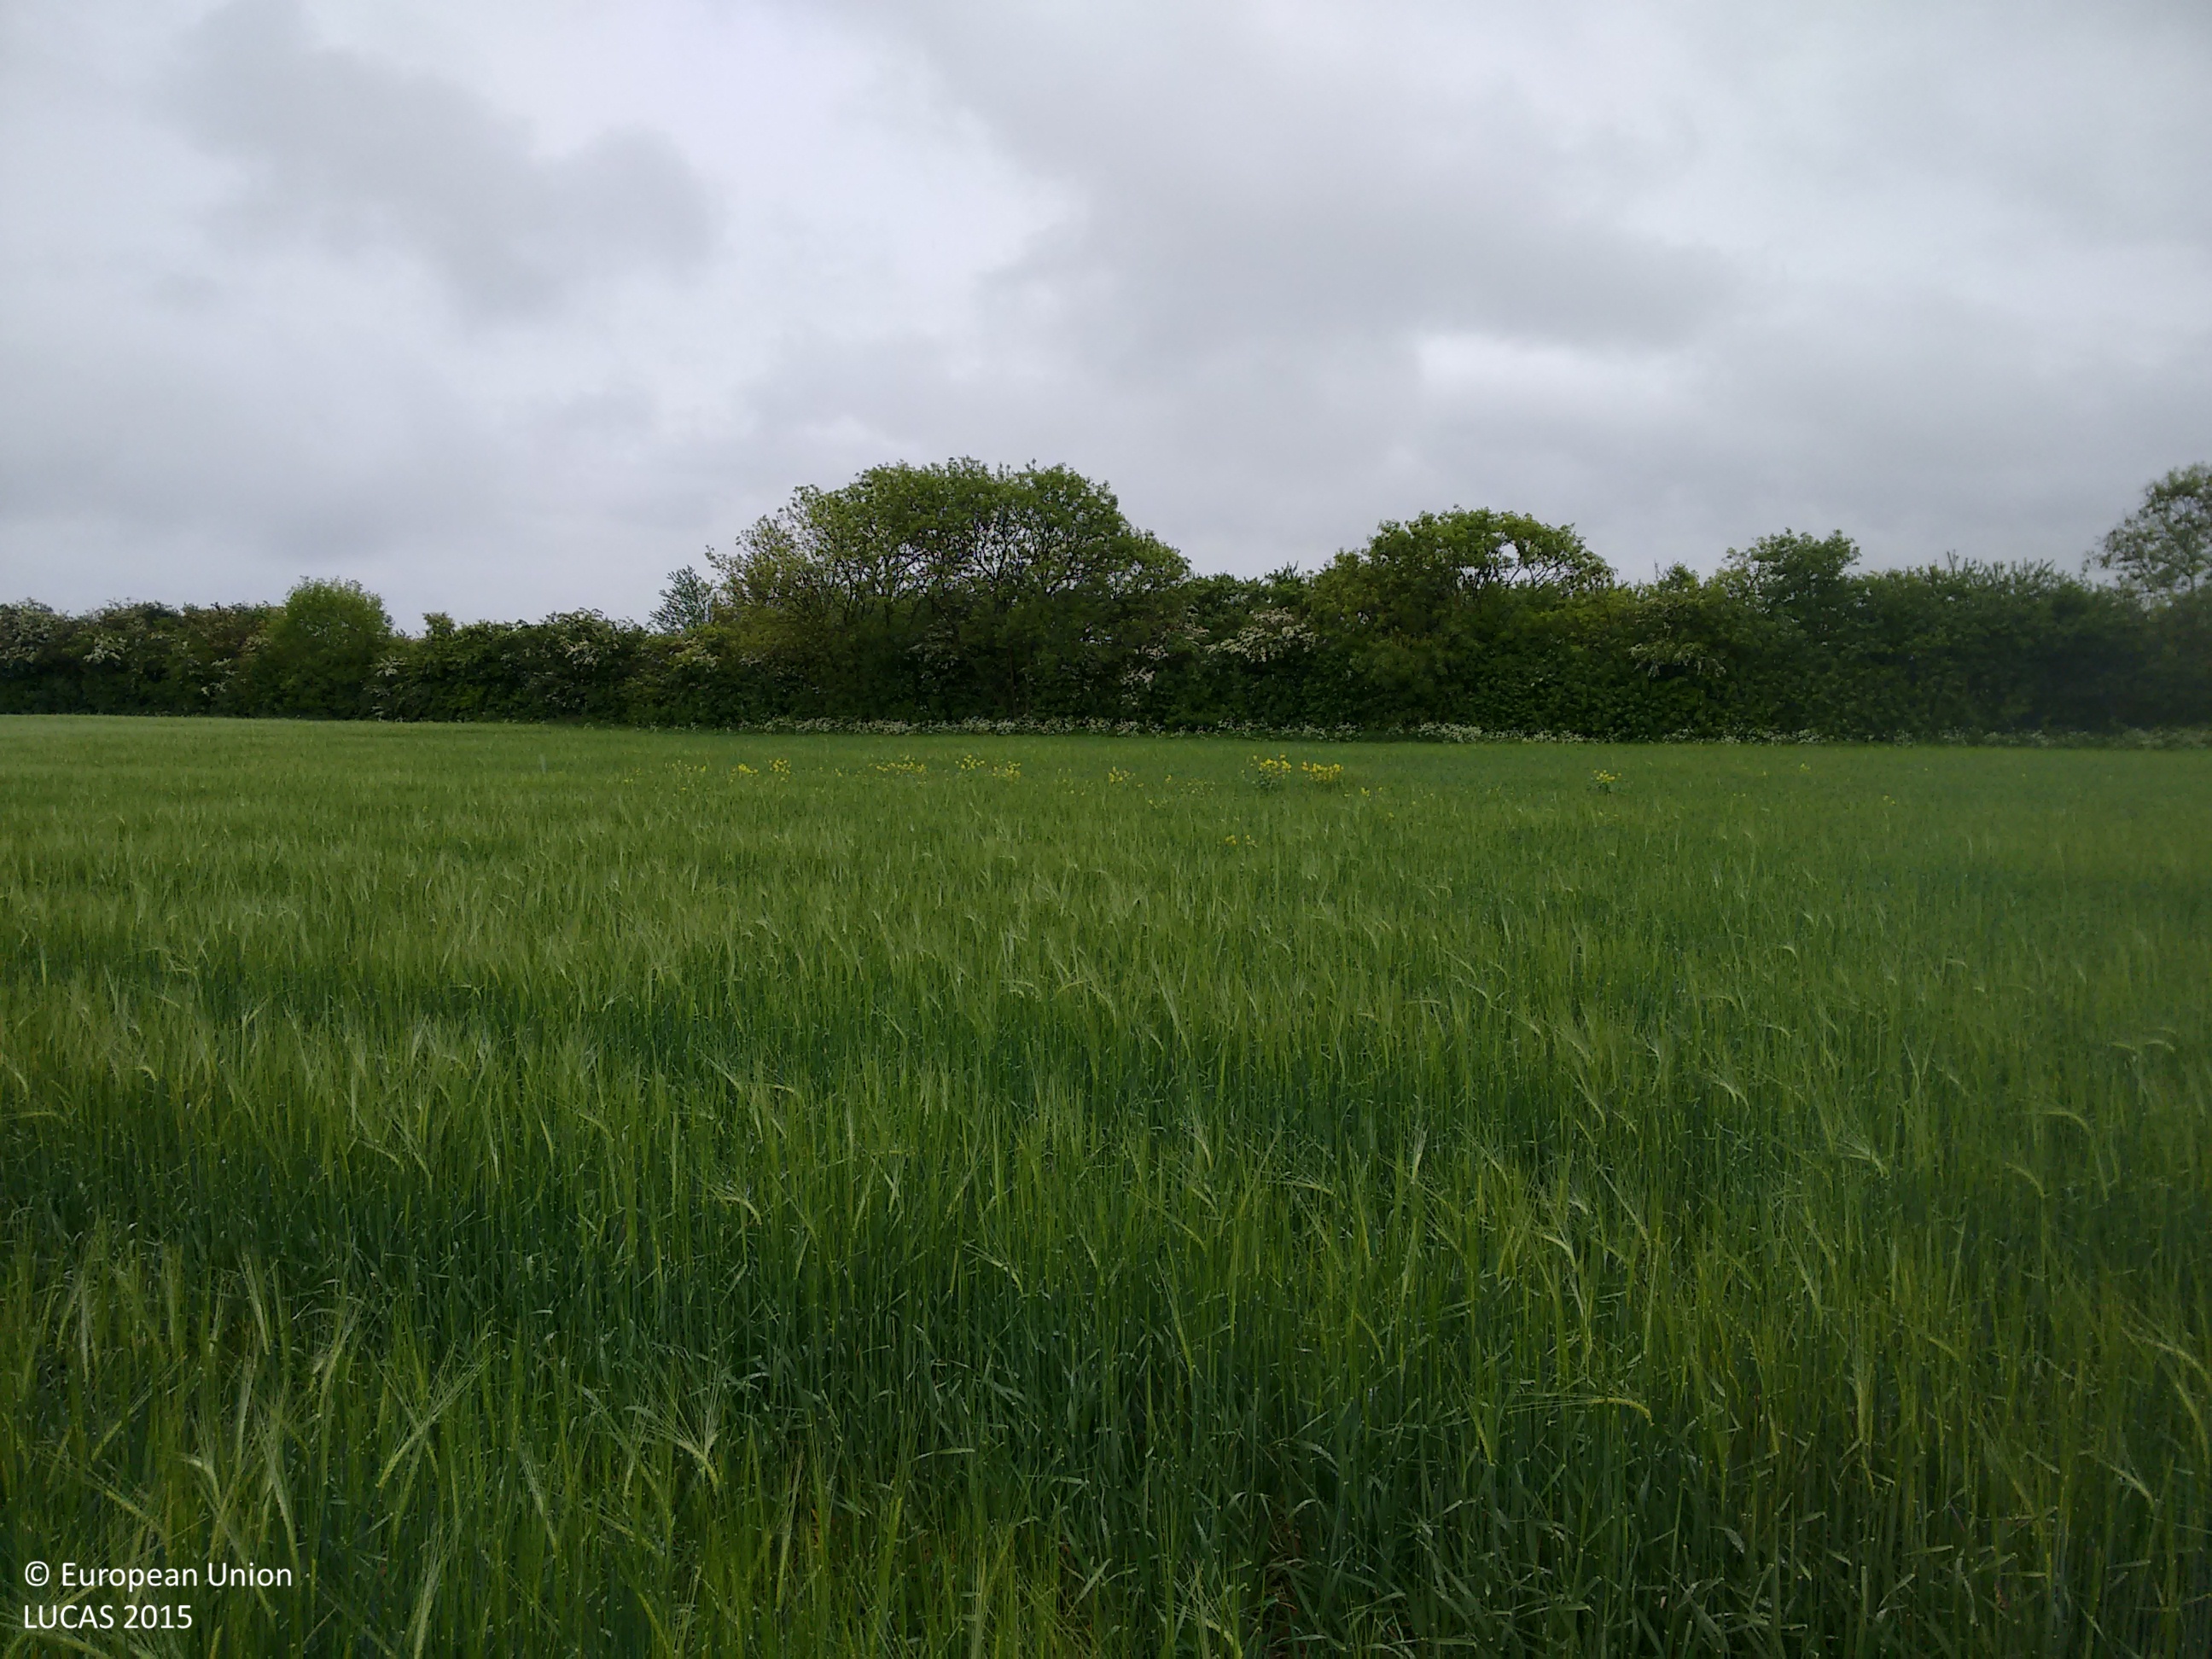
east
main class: Cropland
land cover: Barley
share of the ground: > 75 %
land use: Agriculture (excluding fallow land and kitchen gardens)
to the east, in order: Barley; Grass margins; Managed hedges; Broadleaved woodland; Artificial constructions in urban areas; Rocks and stones; Tracks; Grassland with sparse tree/shrub cover; Managed hedges; Grassland without tree/shrub cover; Grass margins; Barley
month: May
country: GB
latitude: 53.6854
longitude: -0.3161
